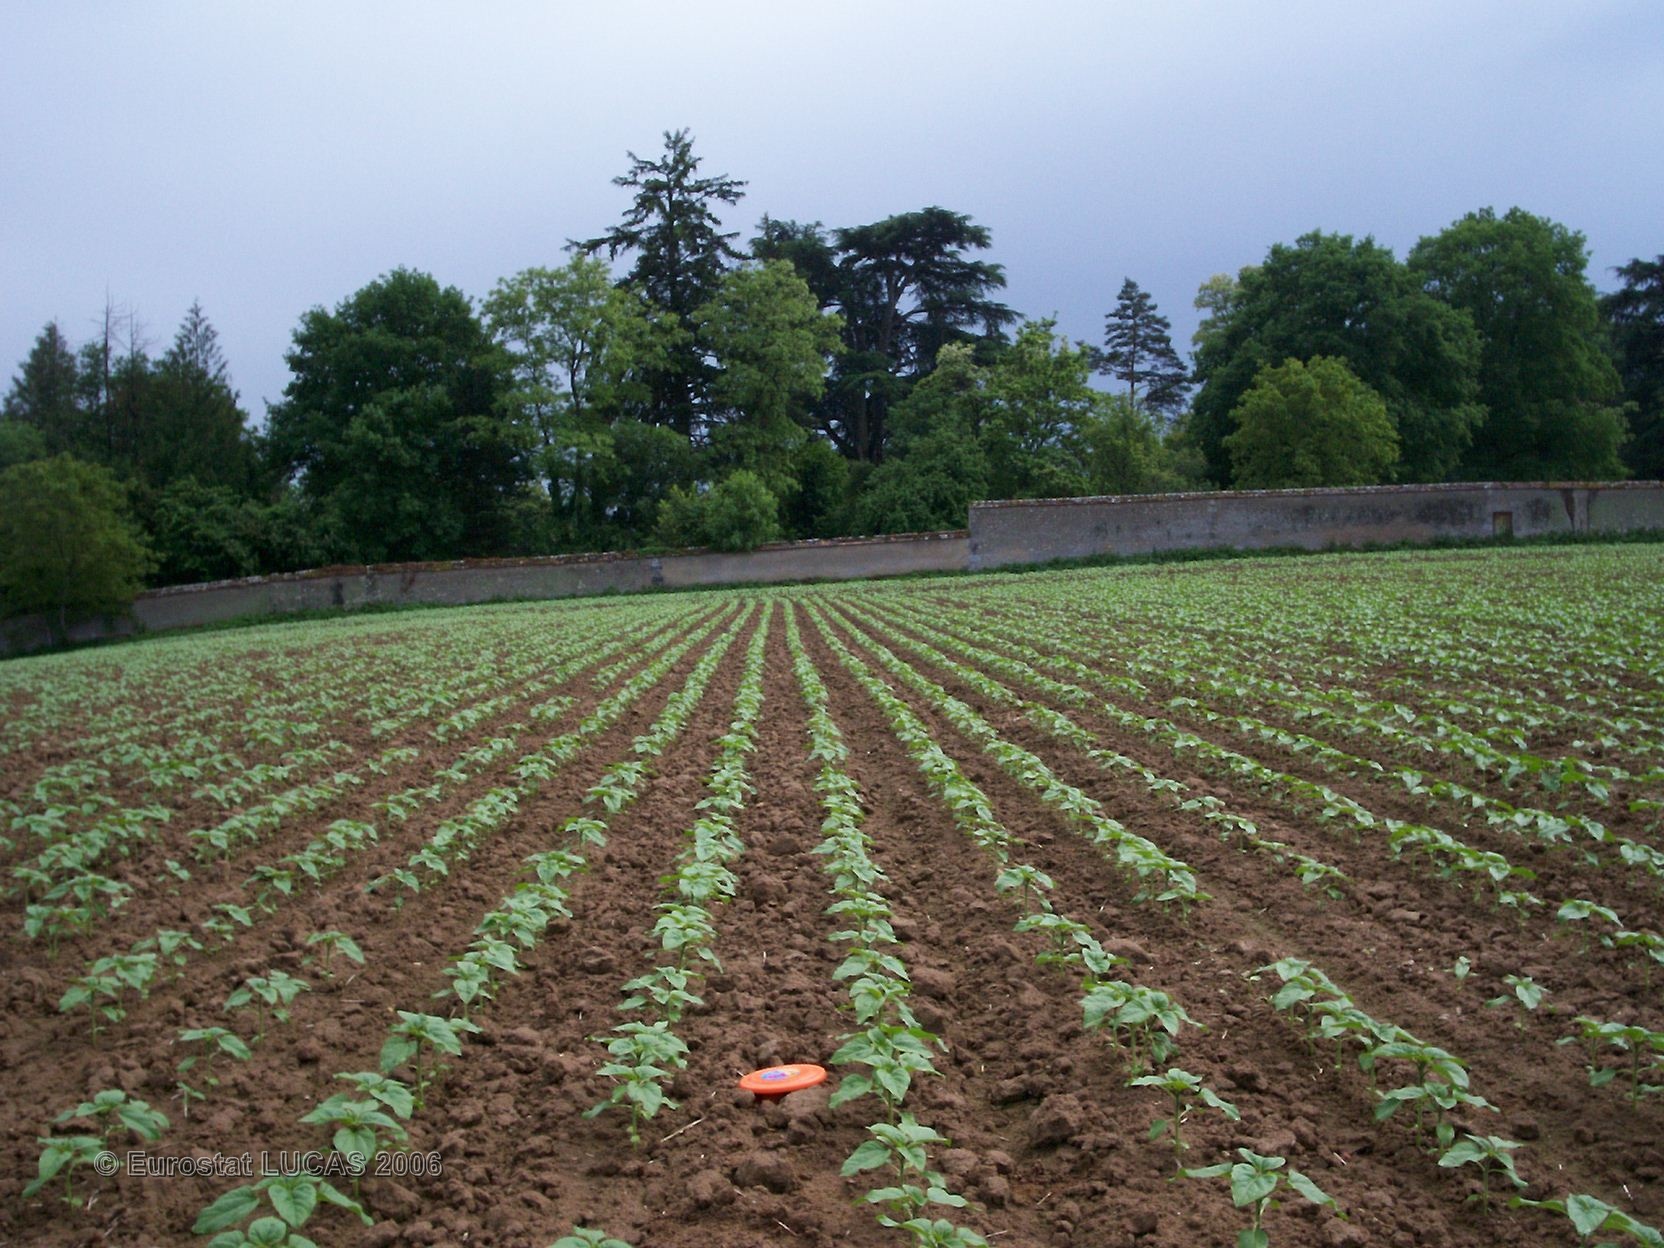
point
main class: Cropland
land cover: Sunflower
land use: Agriculture (excluding fallow land and kitchen gardens)
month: May
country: FR
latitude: 47.1514
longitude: 2.9922
